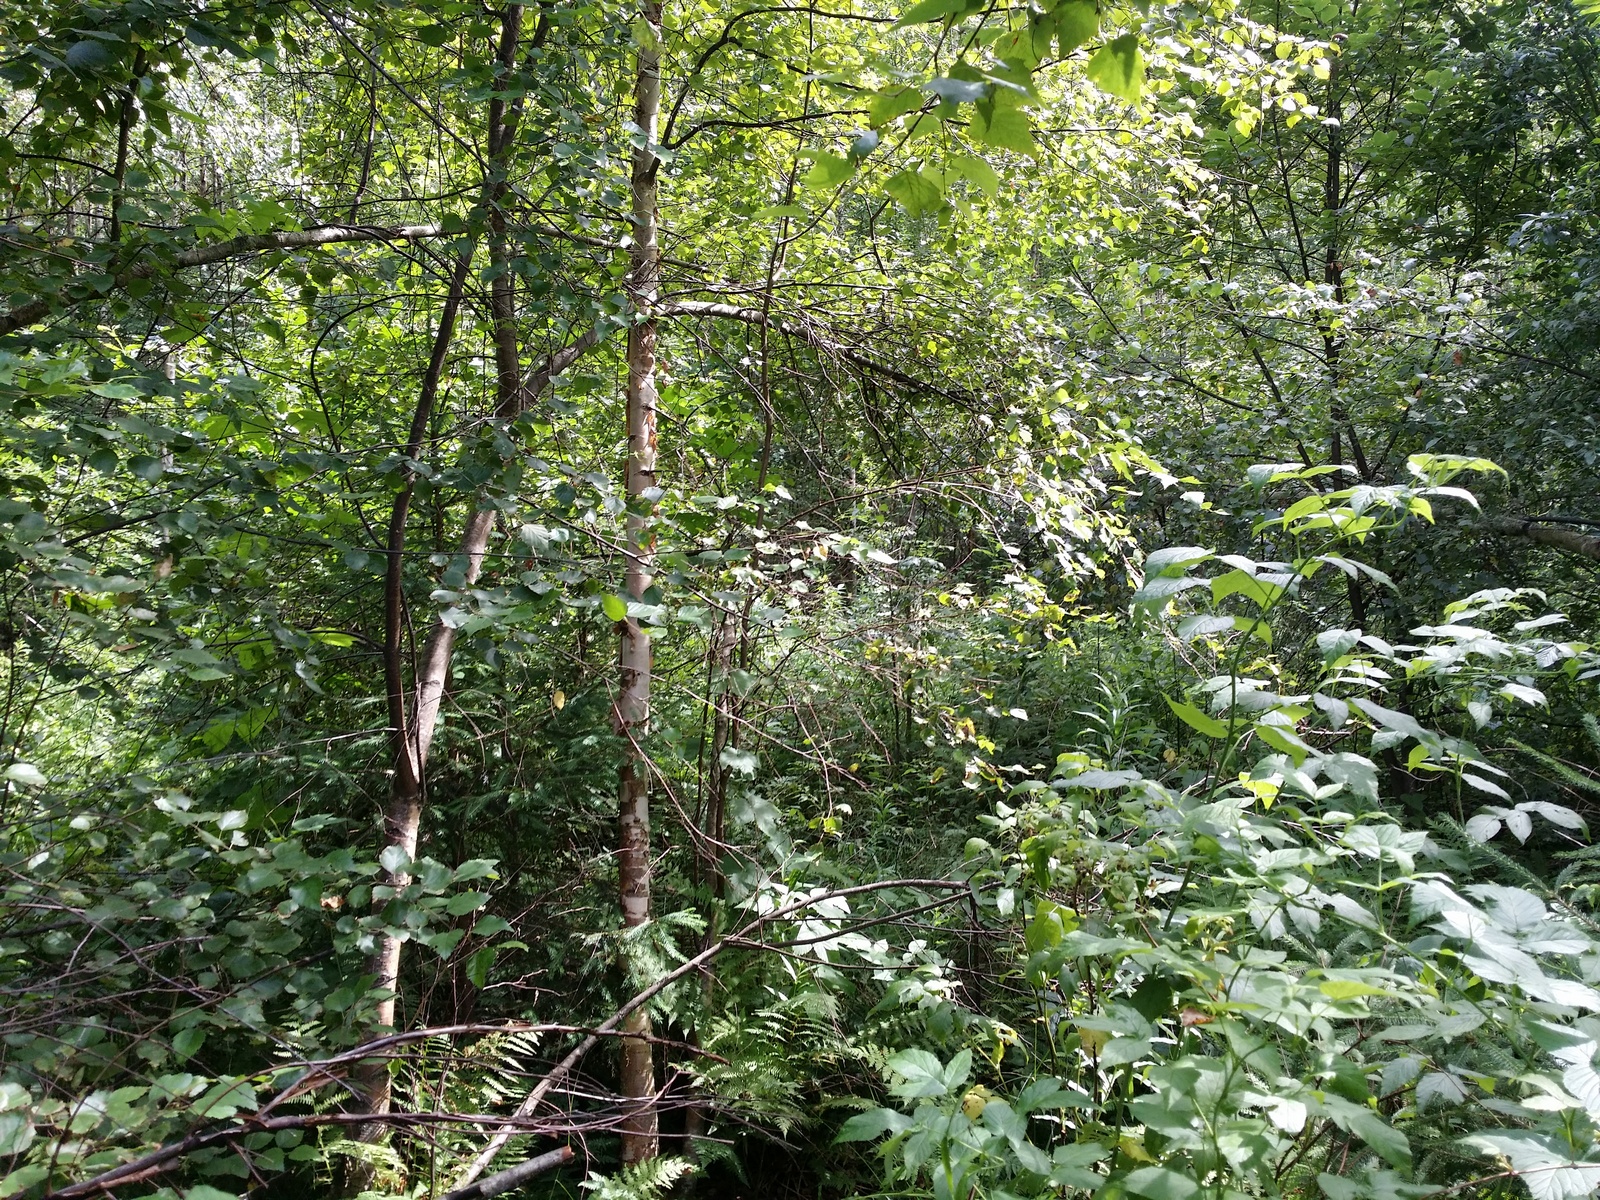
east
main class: Woodland
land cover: Broadleaved woodland
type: non-riverine alder, birch or aspen forest
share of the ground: > 75 %
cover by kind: broadleaved forest trees 90 %, herbaceous plants 10 %
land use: Forestry
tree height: > 5 m
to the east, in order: Broadleaved woodland; Ditches and canals; Grassland without tree/shrub cover
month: August
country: LV
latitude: 57.3979
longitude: 26.8785
